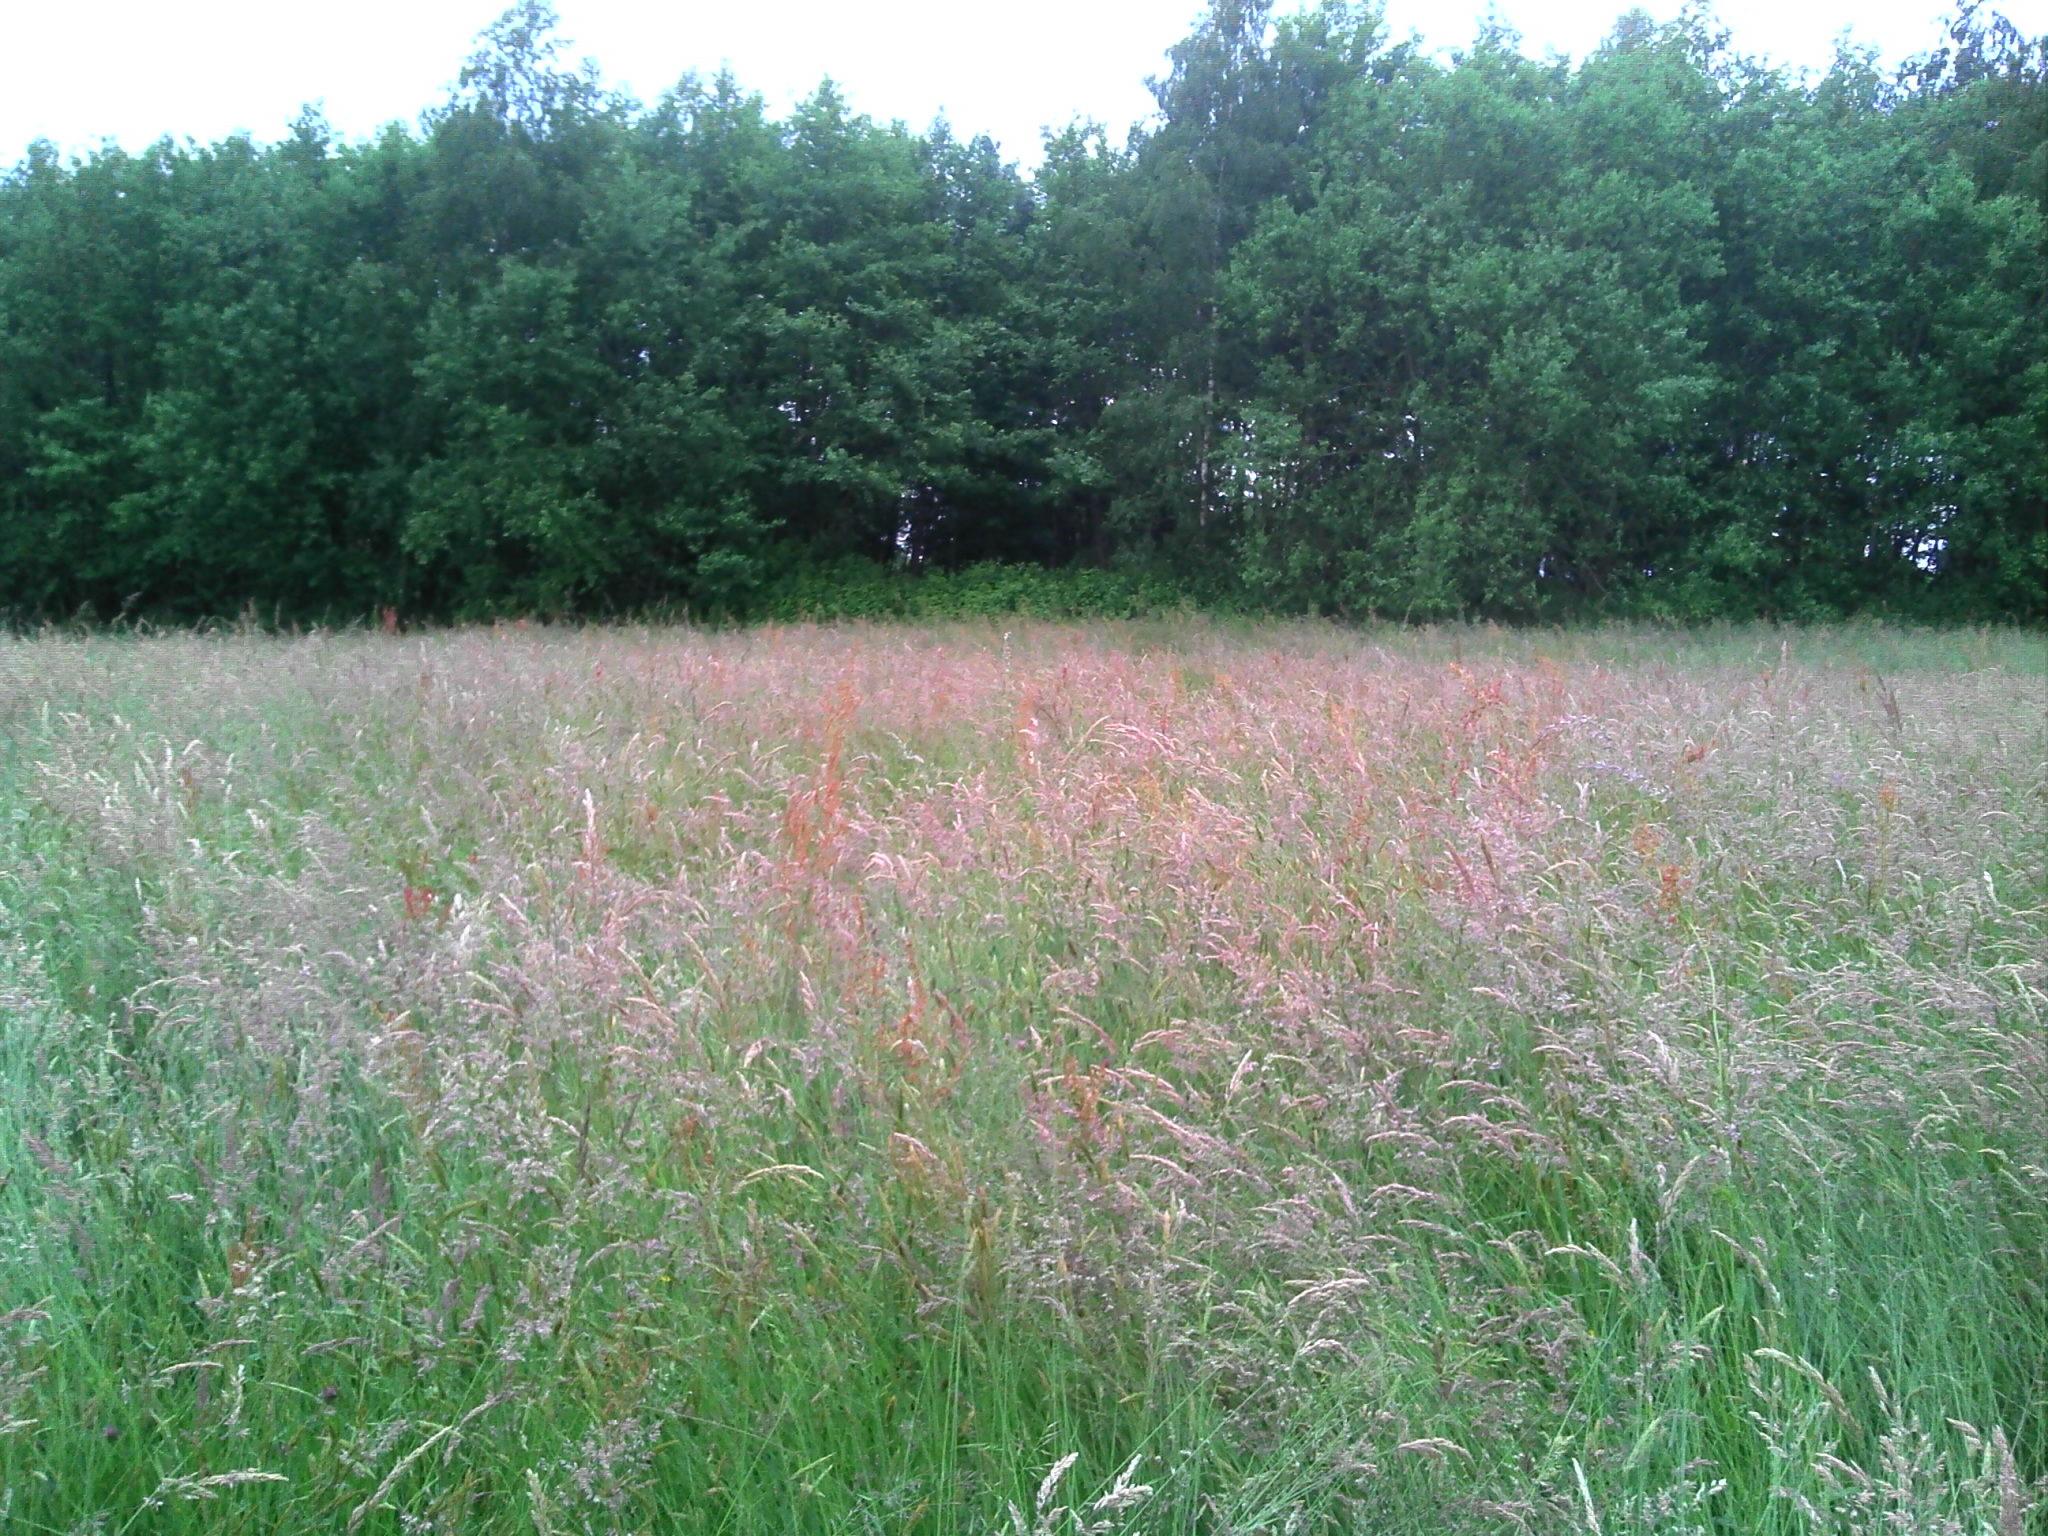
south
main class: Grassland
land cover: Grassland without tree/shrub cover
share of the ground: > 75 %
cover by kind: herbaceous plants 100 %
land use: Agriculture (excluding fallow land and kitchen gardens)
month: May
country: FR
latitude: 46.5735
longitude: 5.3182
